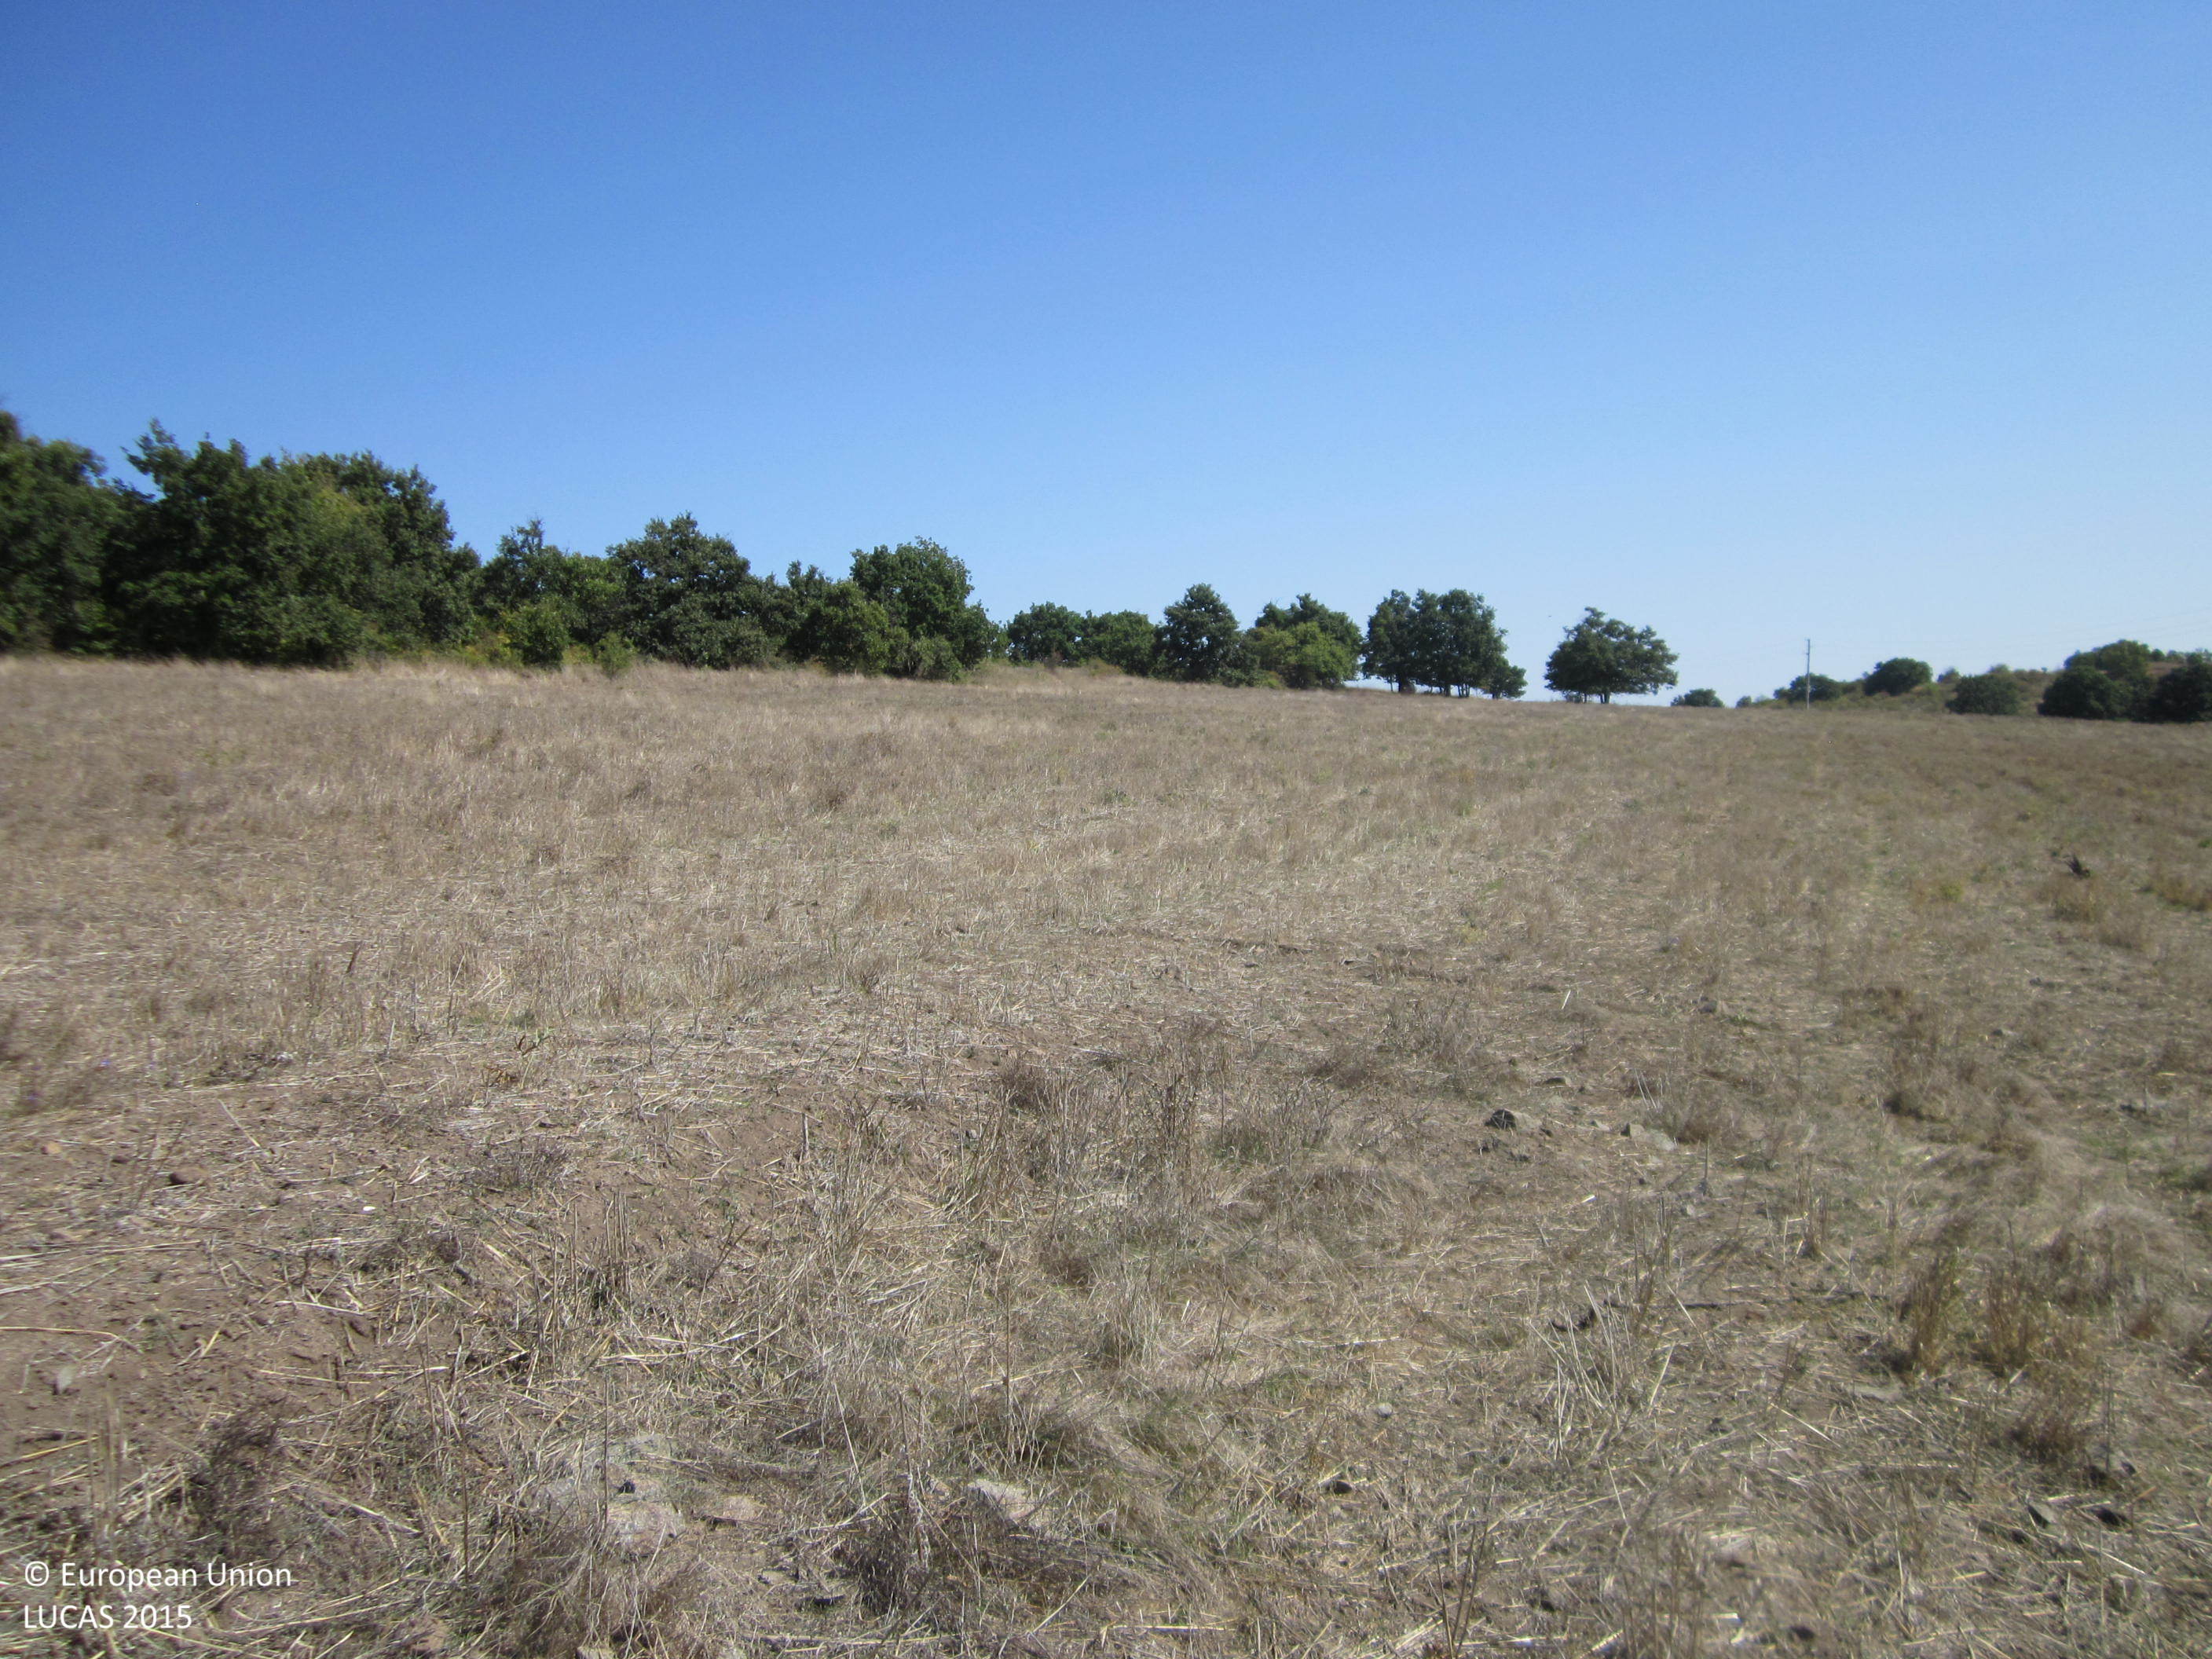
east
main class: Cropland
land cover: Common wheat
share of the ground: < 10 %
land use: Agriculture (excluding fallow land and kitchen gardens)
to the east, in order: Common wheat; Tracks; Grassland without tree/shrub cover; Broadleaved woodland; Grassland without tree/shrub cover
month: September
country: BG
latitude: 42.6980
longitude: 27.4157
